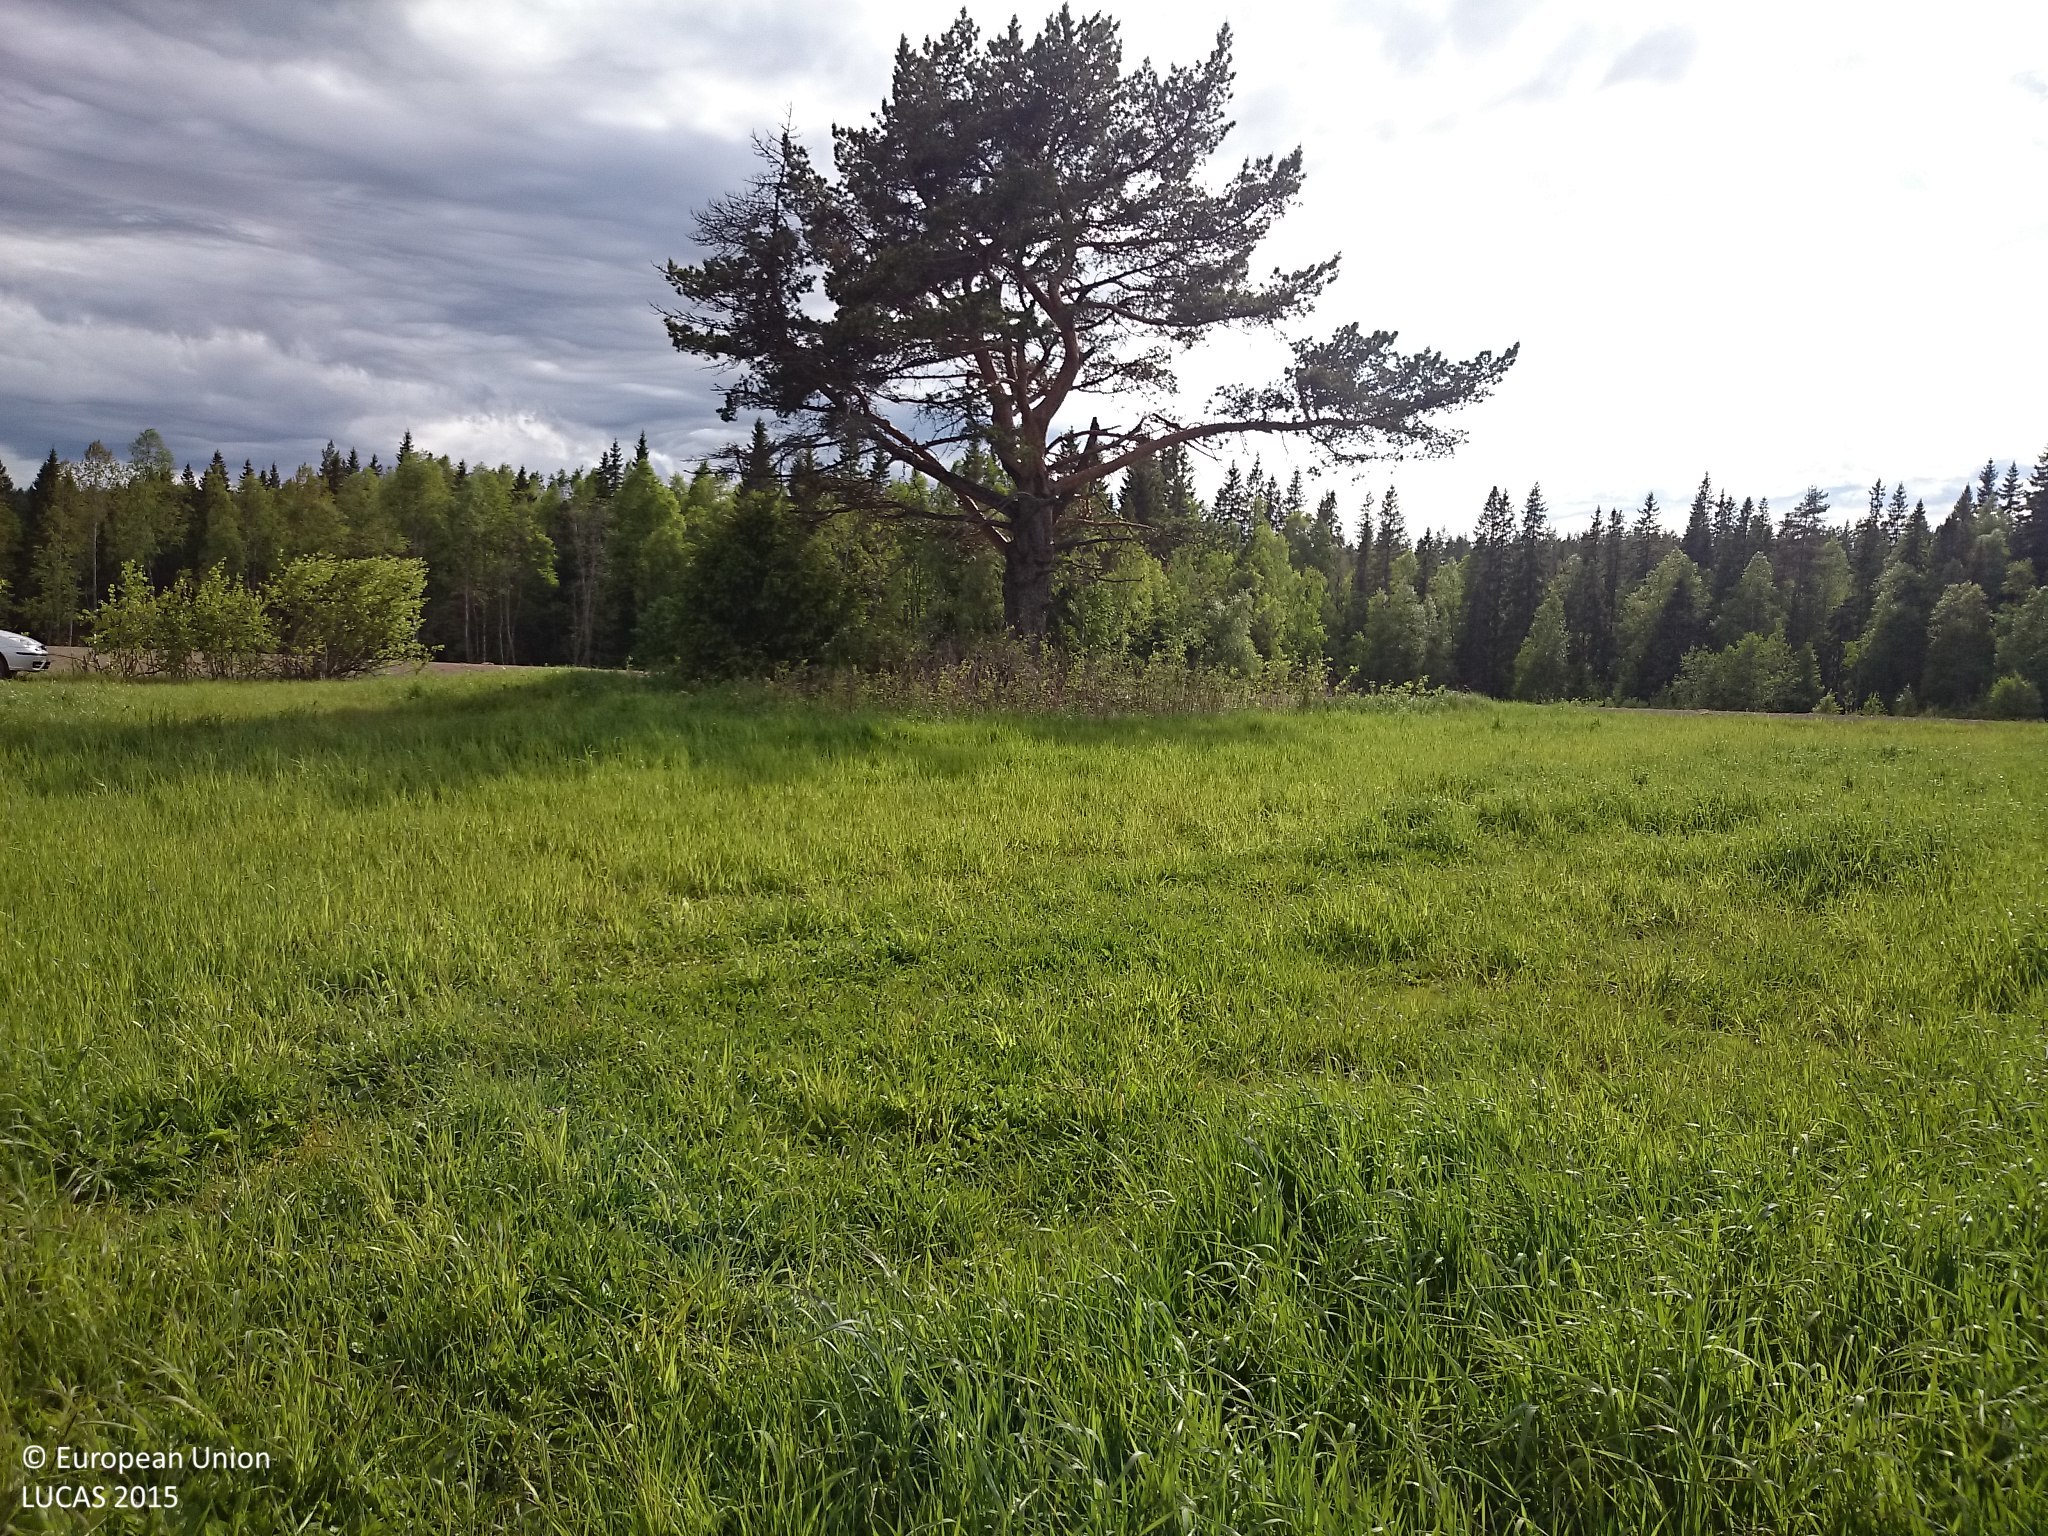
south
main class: Cropland
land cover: Mixed cereals for fodder
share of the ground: > 75 %
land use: Agriculture (excluding fallow land and kitchen gardens)
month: June
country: SE
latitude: 64.0870
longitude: 20.7505
